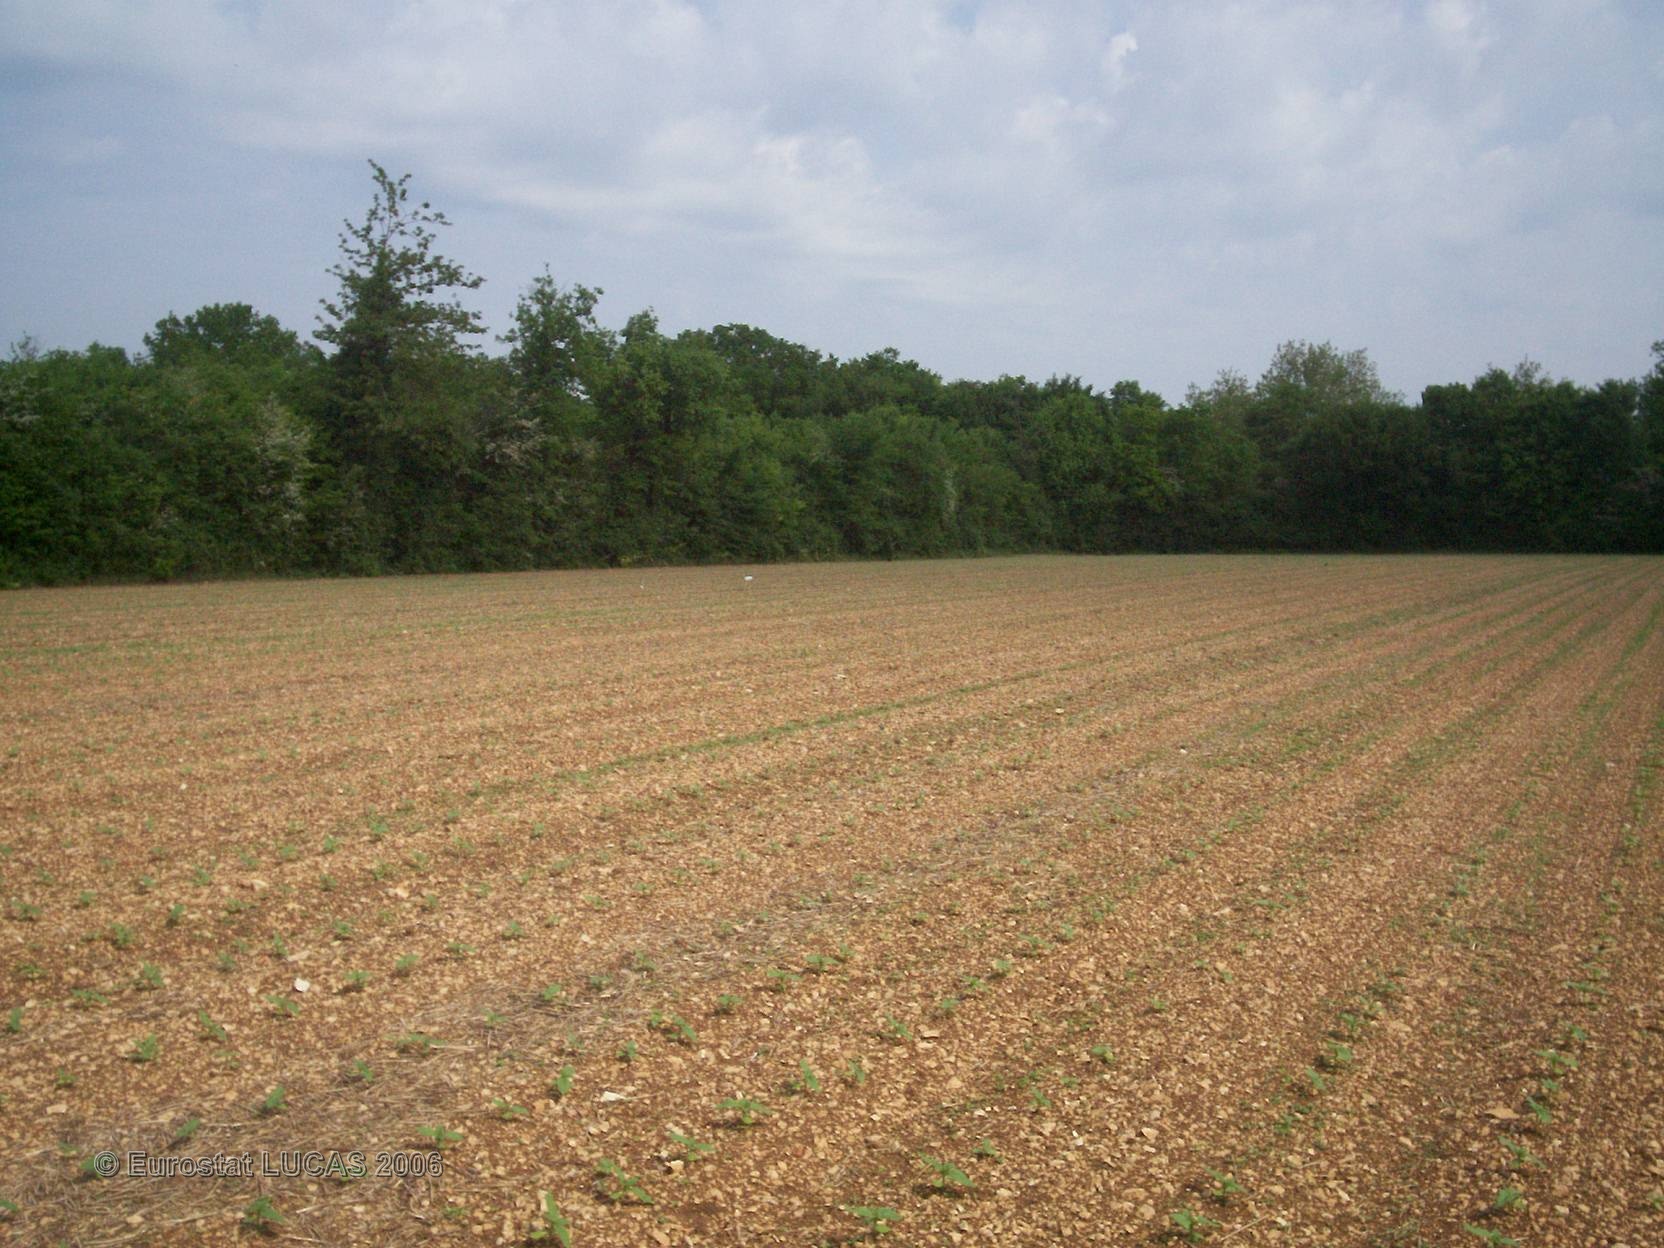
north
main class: Cropland
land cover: Sunflower
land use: Agriculture (excluding fallow land and kitchen gardens)
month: May
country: FR
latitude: 46.0778
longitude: -0.2241
